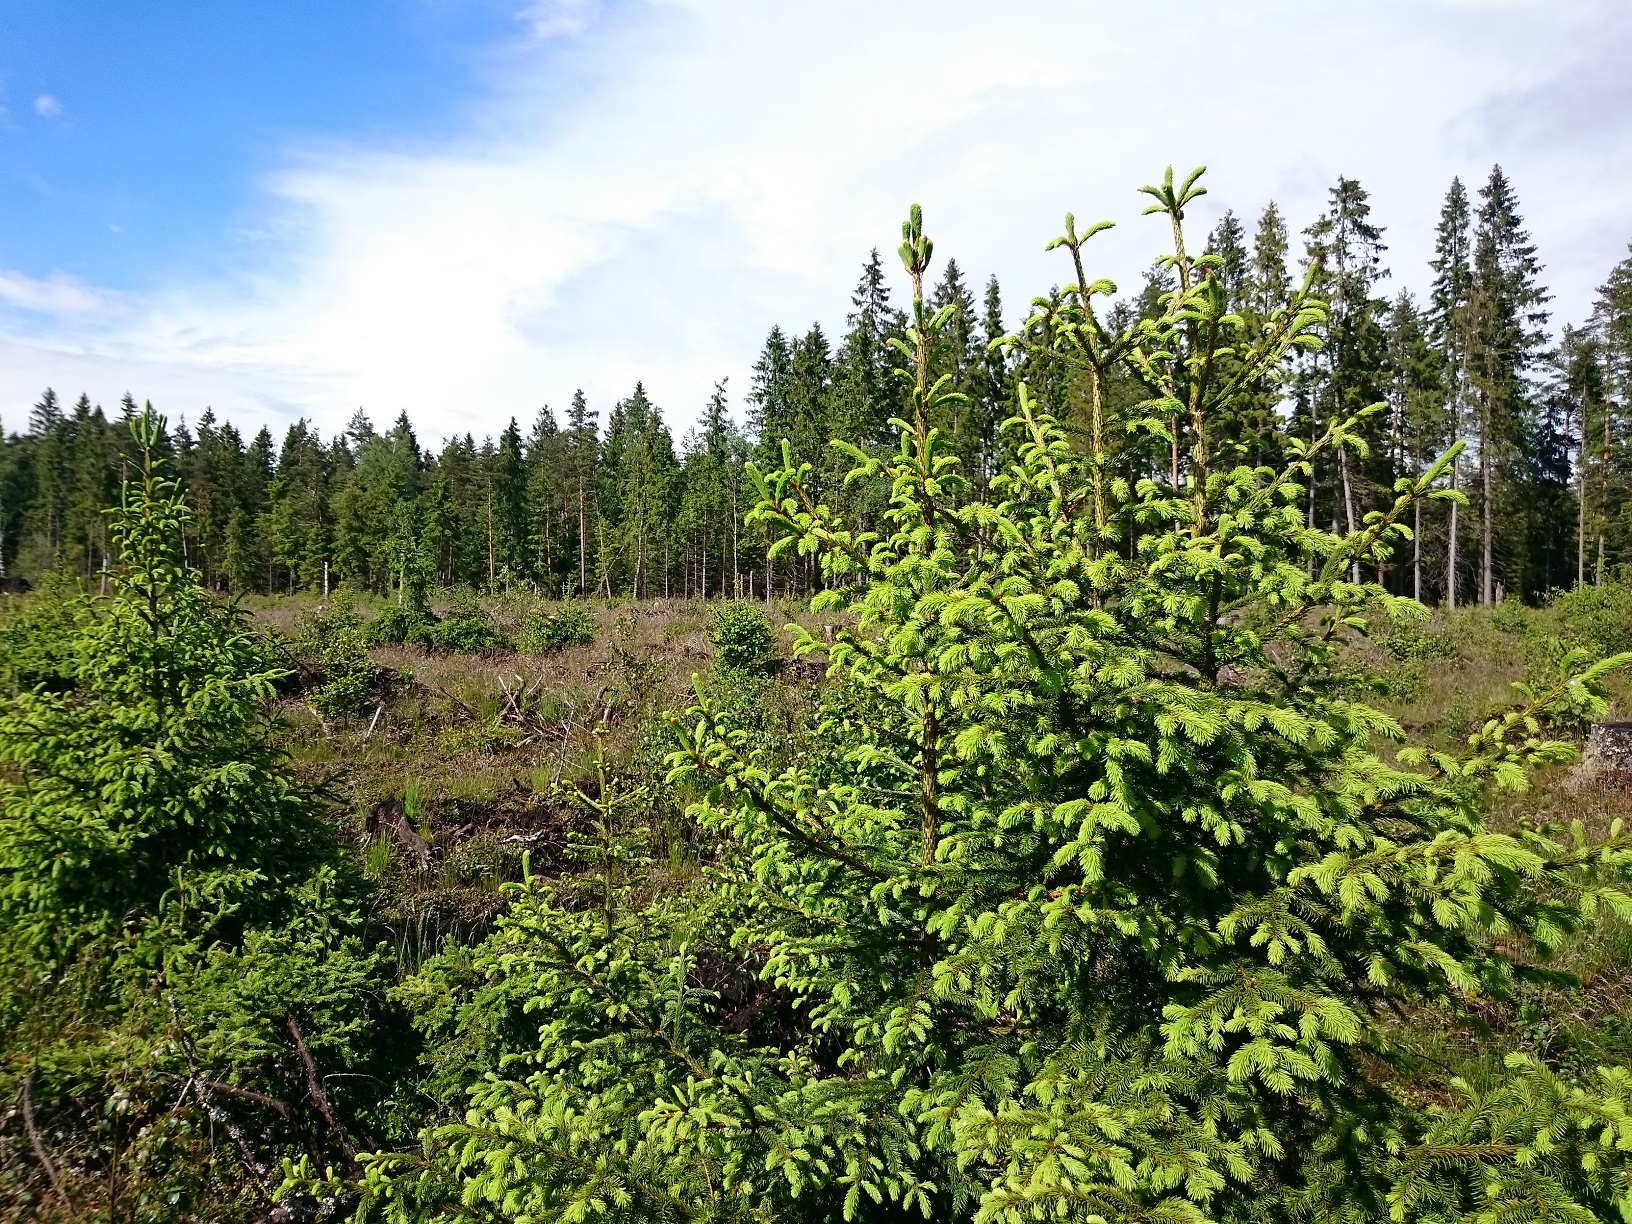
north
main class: Woodland
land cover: Spruce dominated mixed woodland
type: boreal forest
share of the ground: 25 - 50 %
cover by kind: shrubs 30 %, coniferous forest trees 25 %, broadleaved forest trees 25 %, herbaceous plants 10 %, lichens and mosses 10 %
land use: Forestry
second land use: Amenities, museums, leisure
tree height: < 5 m
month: June
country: SE
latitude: 56.9793
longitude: 14.3238
